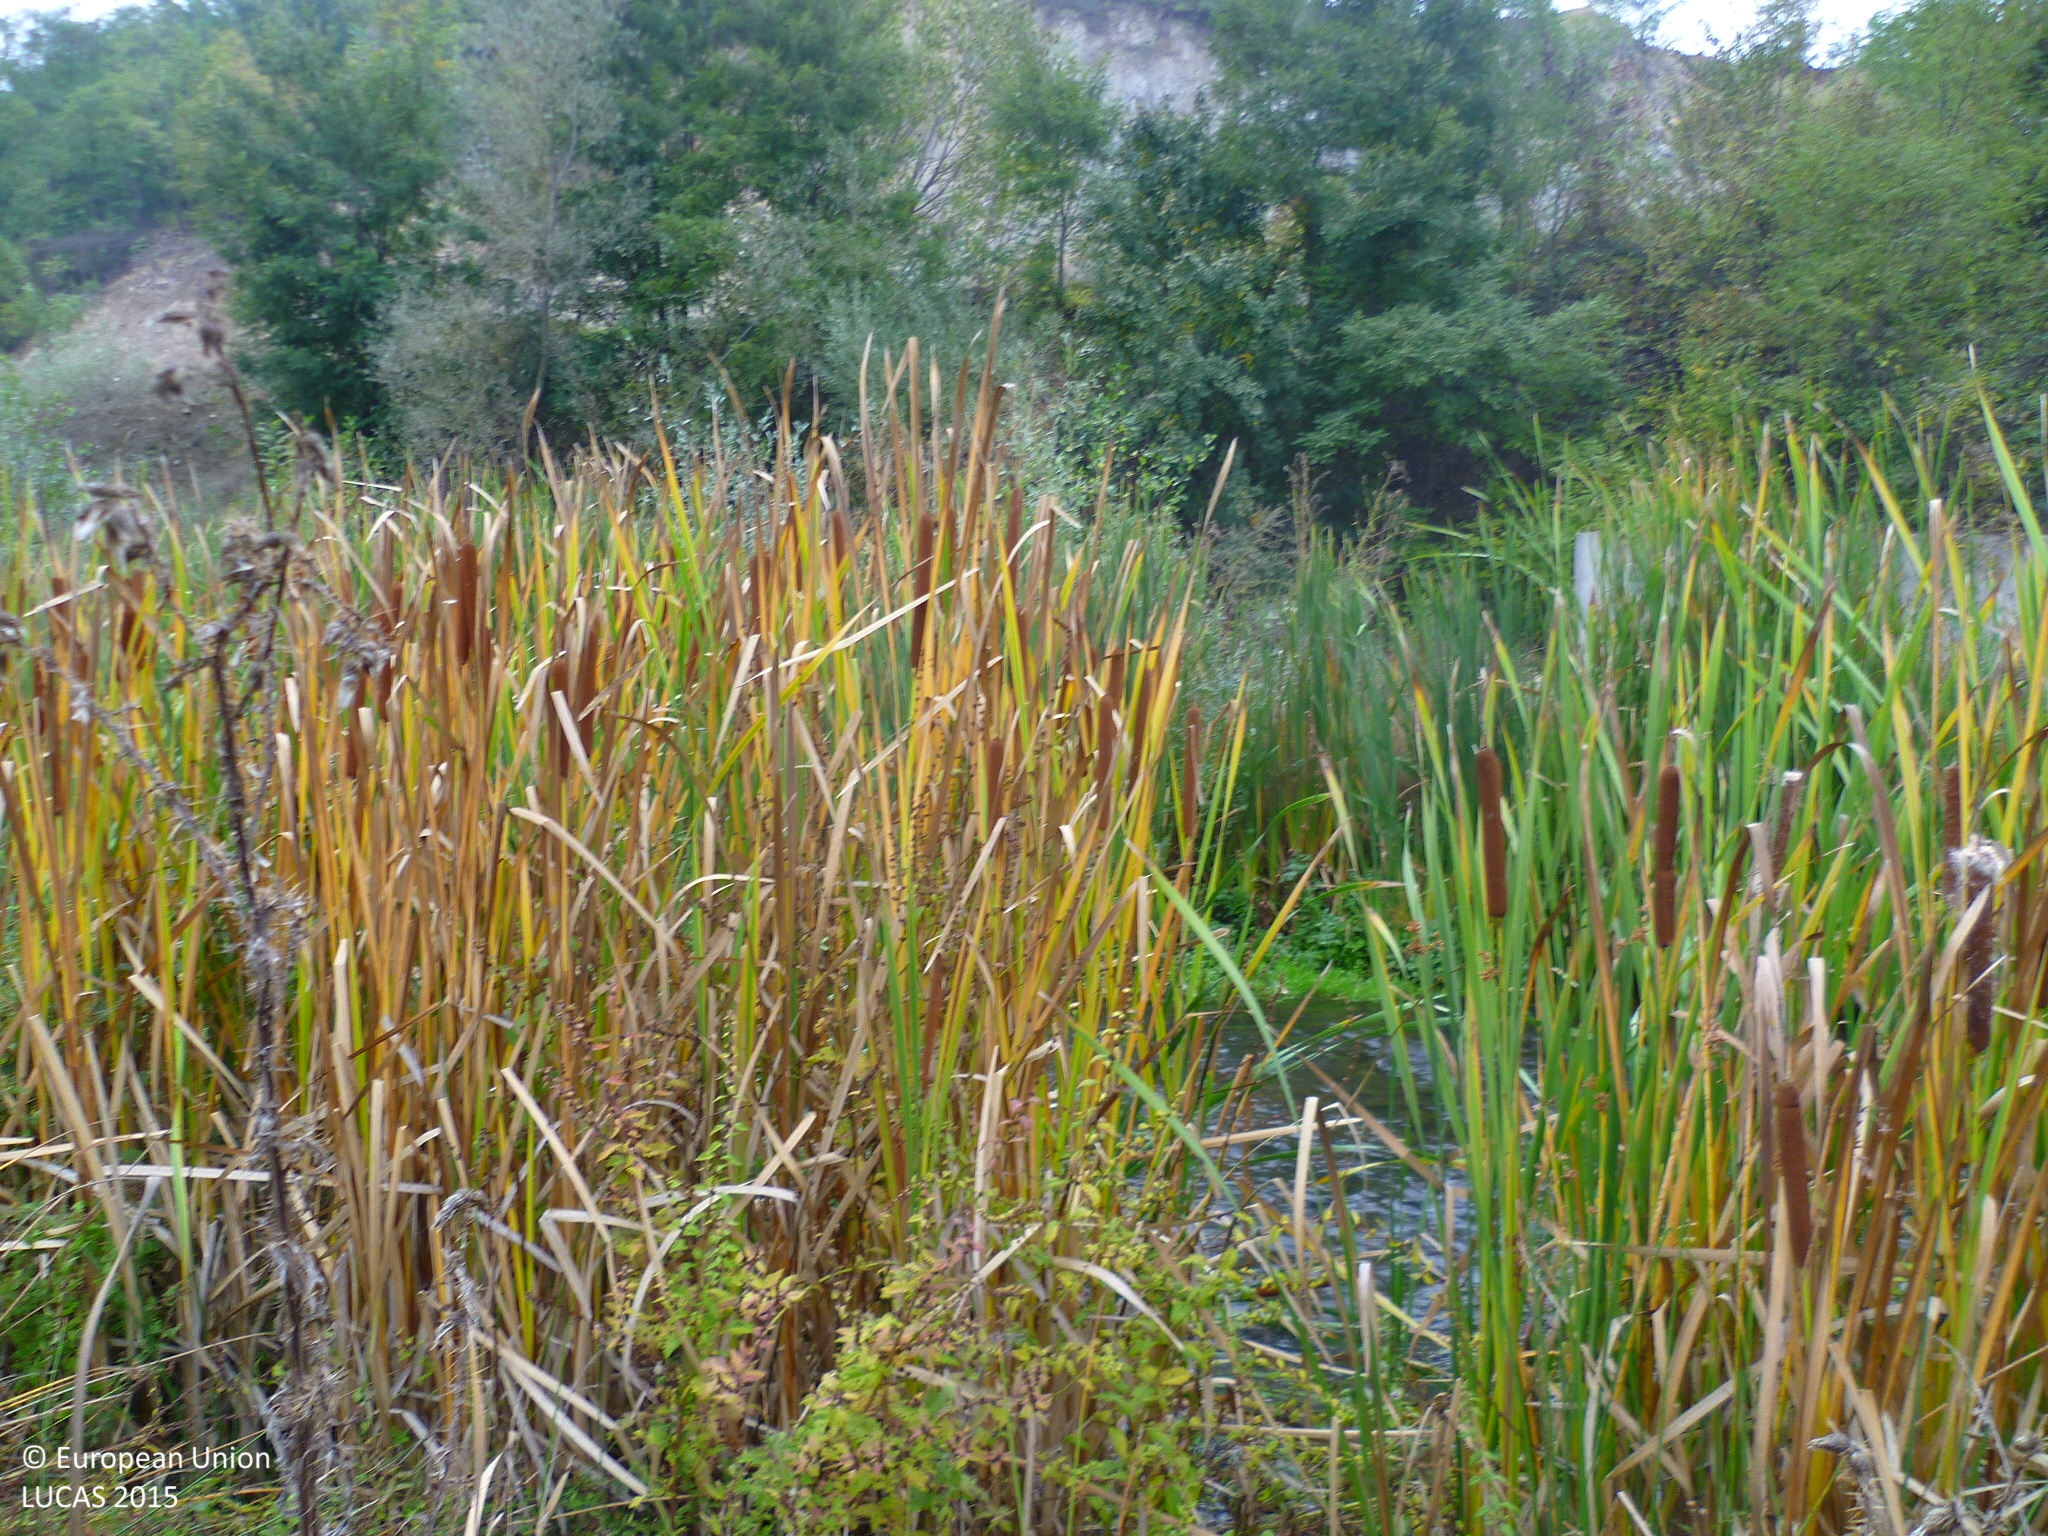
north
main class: Grassland
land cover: Spontaneously vegetated surfaces
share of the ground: > 75 %
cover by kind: herbaceous plants 100 %
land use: Semi-natural and natural areas not in use
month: October
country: BG
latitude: 42.3182
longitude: 23.8584
